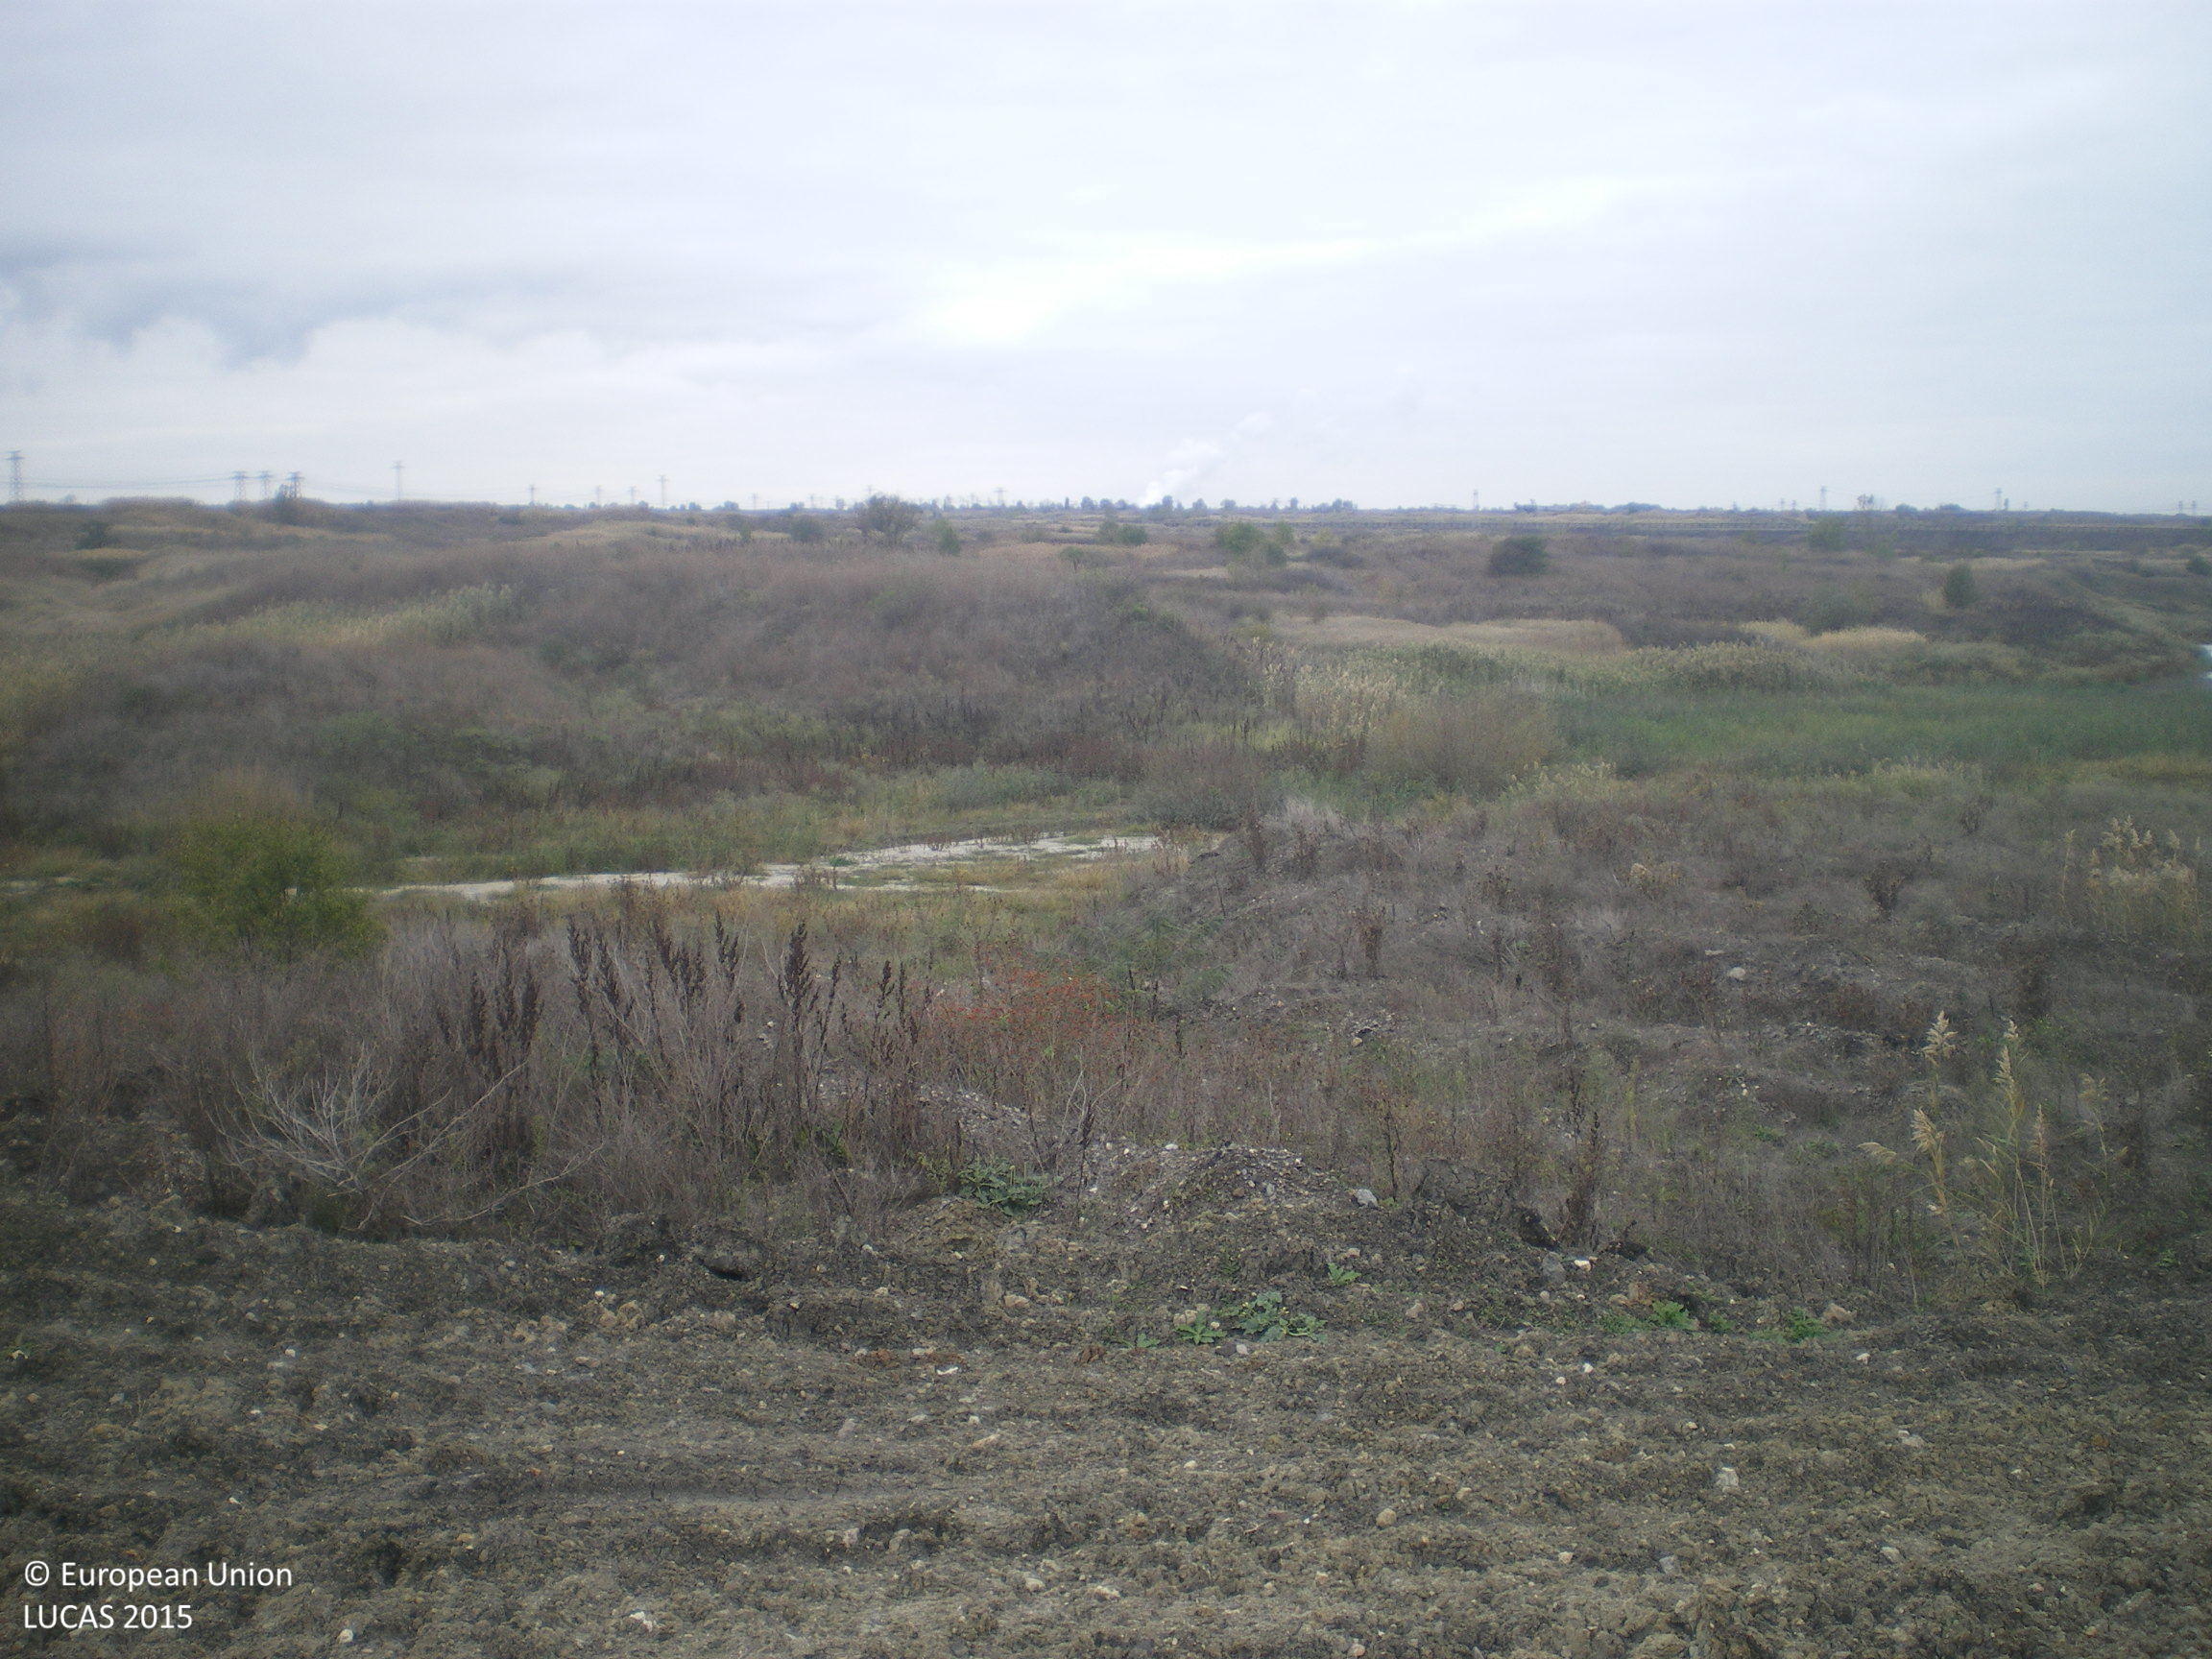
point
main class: Grassland
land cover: Grassland without tree/shrub cover
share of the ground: > 75 %
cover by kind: herbaceous plants 100 %
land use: Mining and quarrying
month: October
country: BG
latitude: 42.1989
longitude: 26.0025
